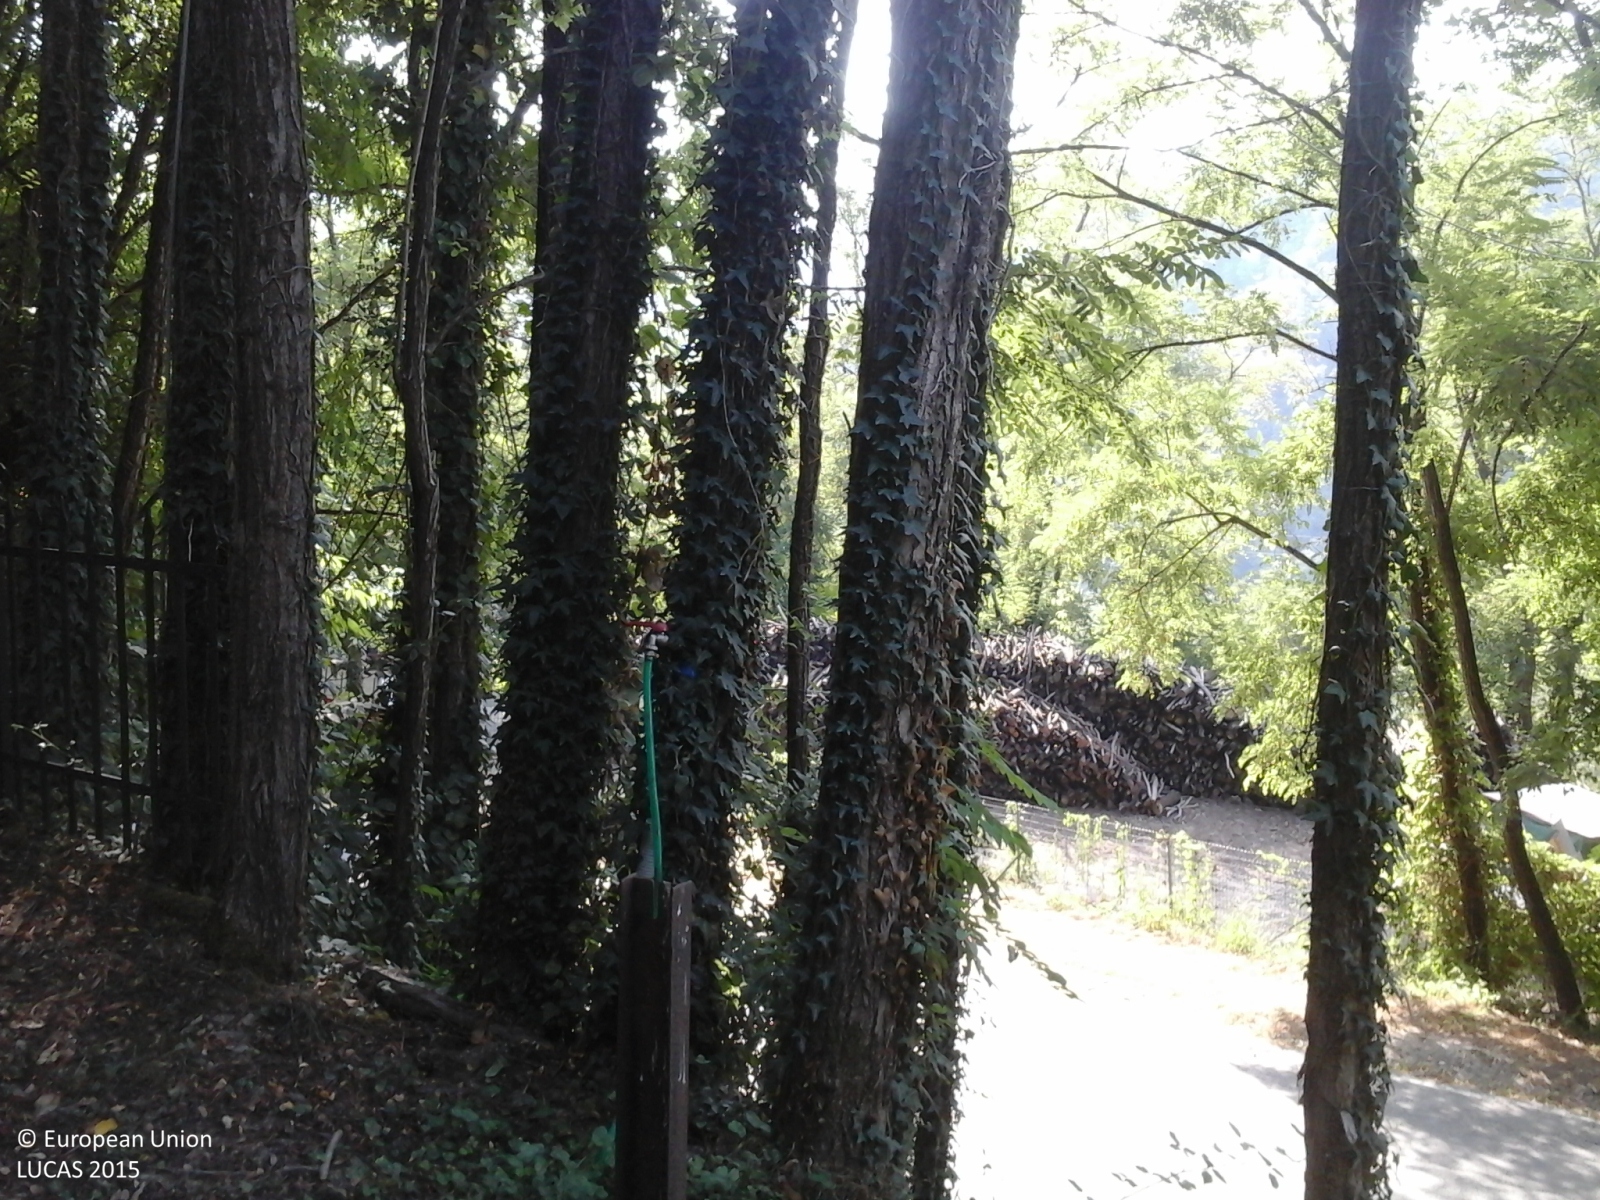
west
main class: Woodland
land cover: Broadleaved woodland
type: thermophilous deciduous forest
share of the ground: > 75 %
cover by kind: broadleaved forest trees 100 %
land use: Forestry
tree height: > 5 m
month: August
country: IT
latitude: 43.9332
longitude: 10.7082
